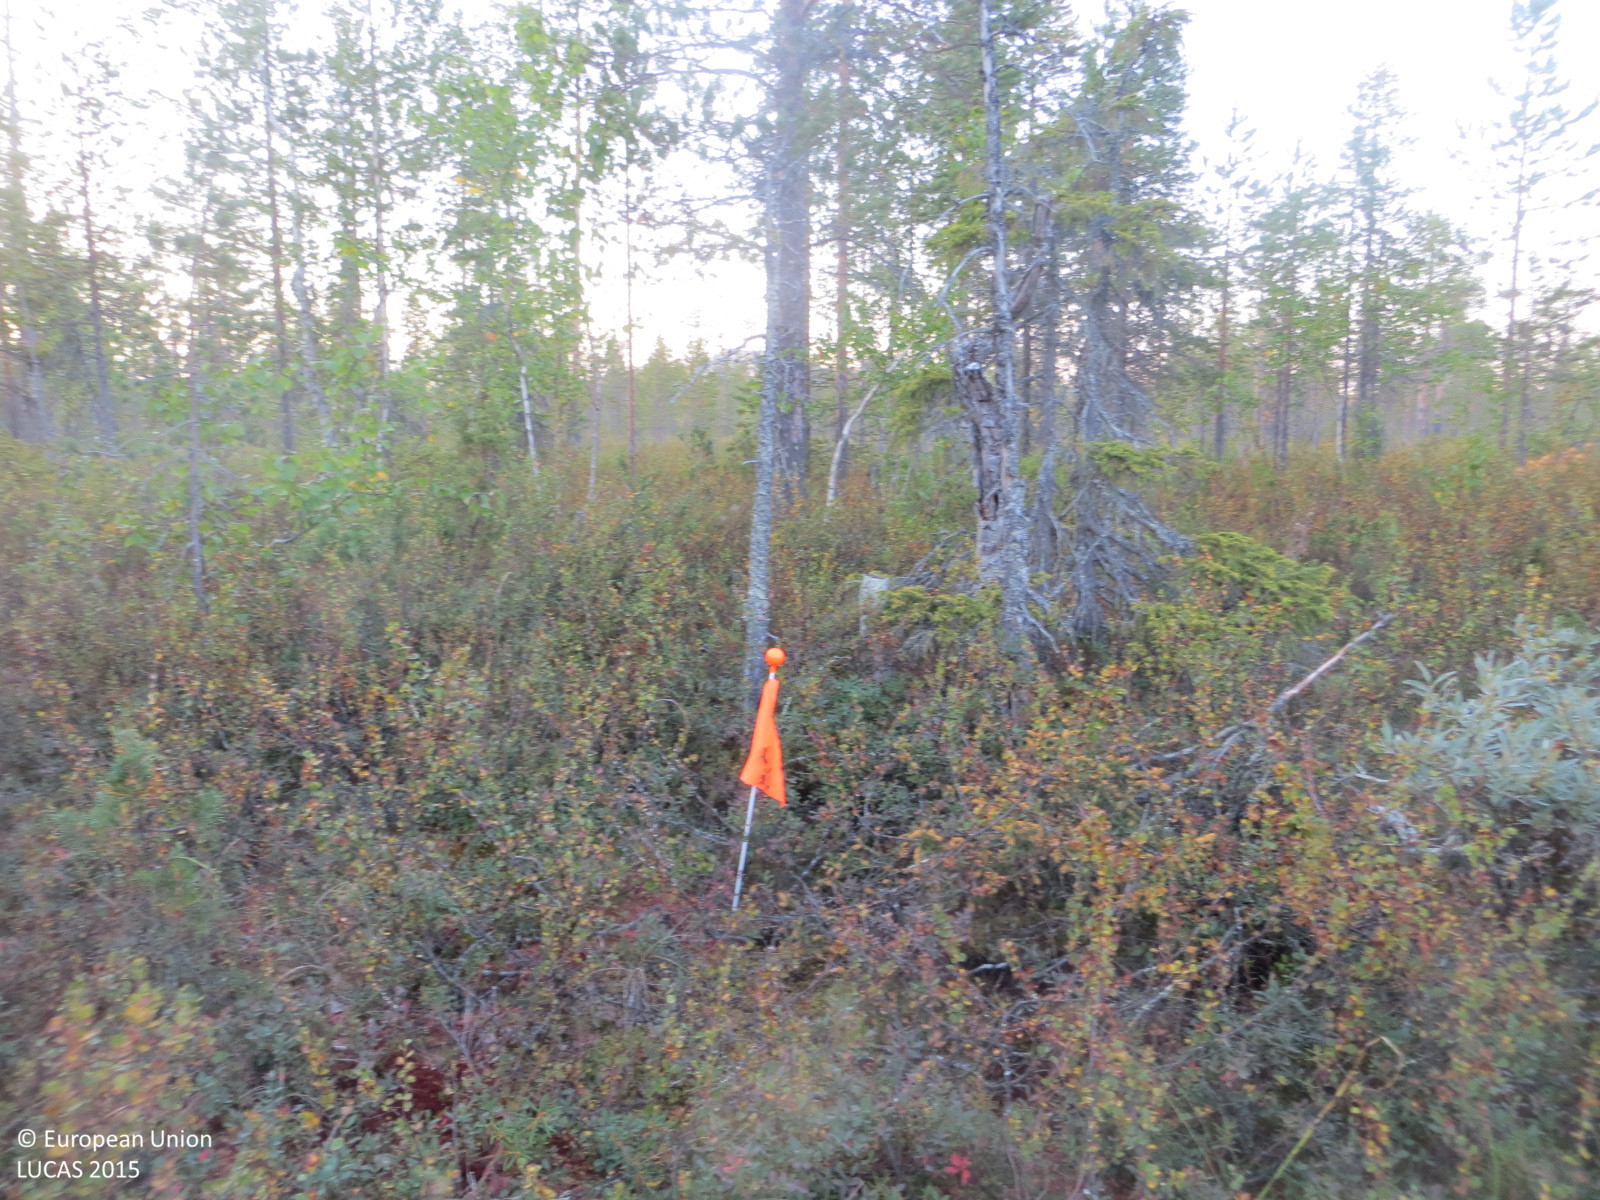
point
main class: Woodland
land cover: Pine dominated mixed woodland
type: mire and swamp forests
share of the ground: 50 - 75 %
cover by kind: shrubs 50 %, coniferous forest trees 30 %, broadleaved forest trees 20 %
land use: Forestry
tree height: > 5 m
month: August
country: FI
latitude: 67.7420
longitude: 24.8667
